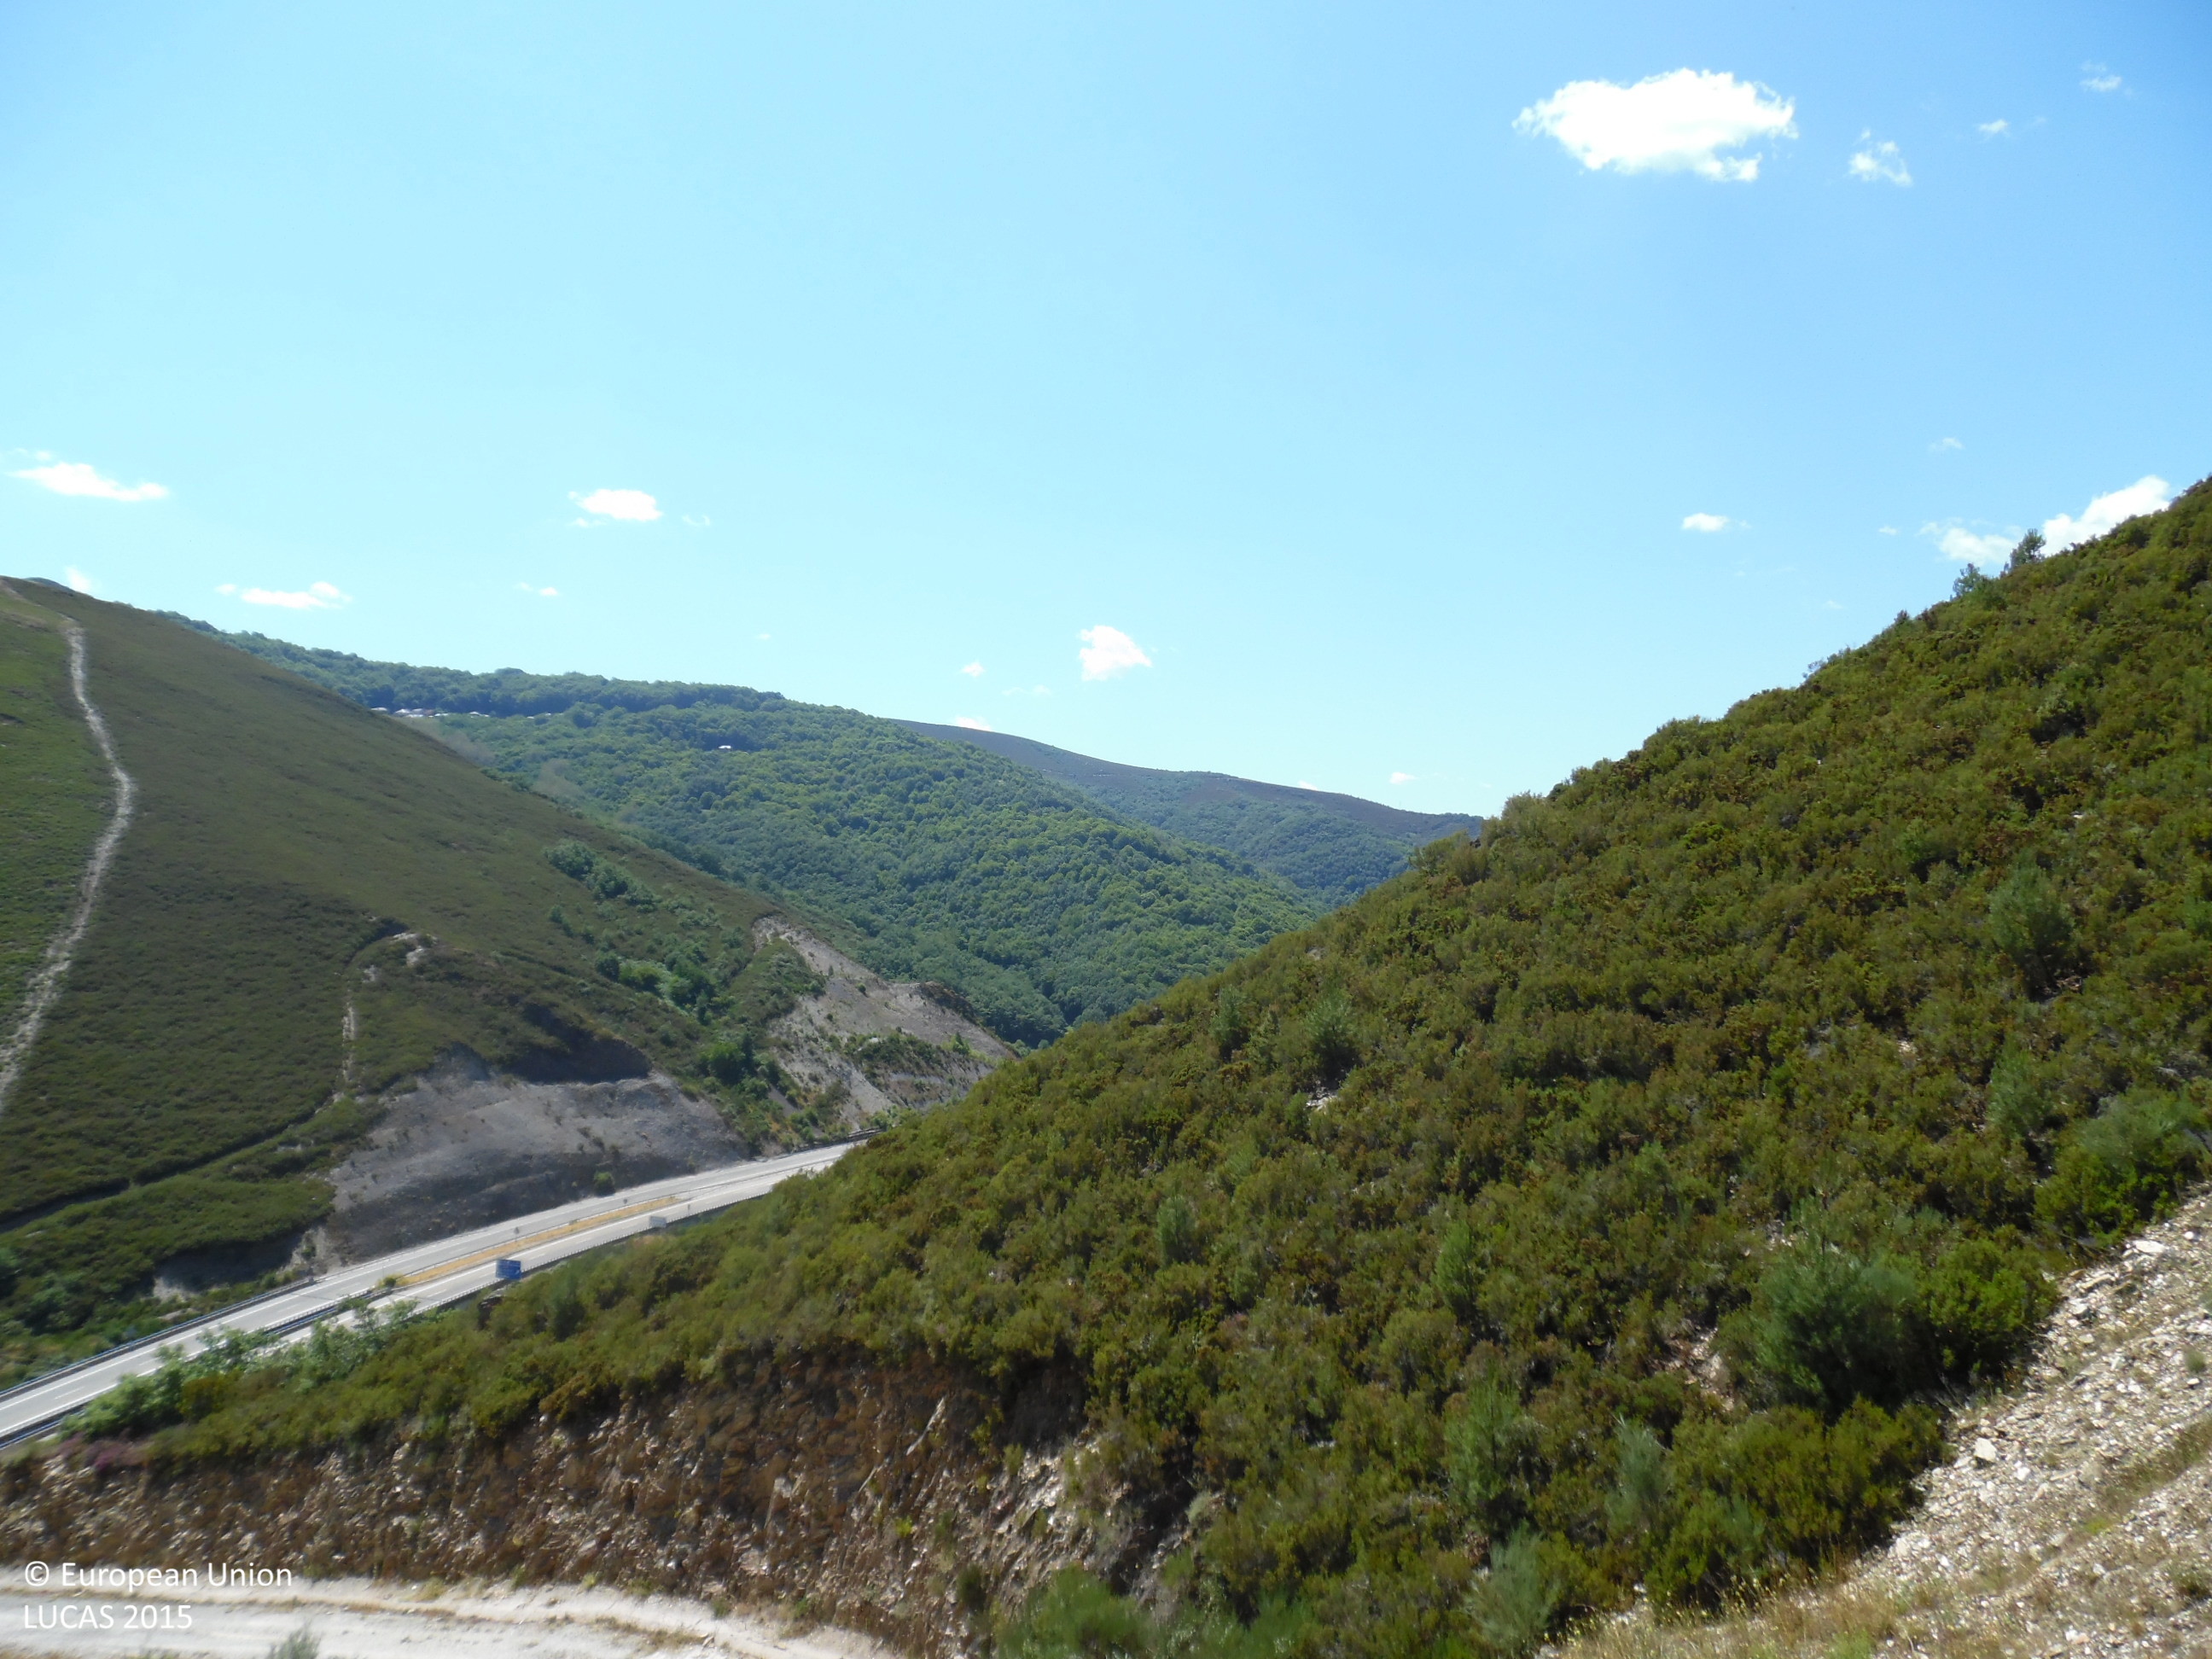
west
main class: Grassland
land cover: Grassland with sparse tree/shrub cover
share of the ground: > 75 %
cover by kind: herbaceous plants 95 %, broadleaved forest trees 5 %
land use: Abandoned areas
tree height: < 5 m
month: June
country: ES
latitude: 42.6572
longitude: -6.9025
